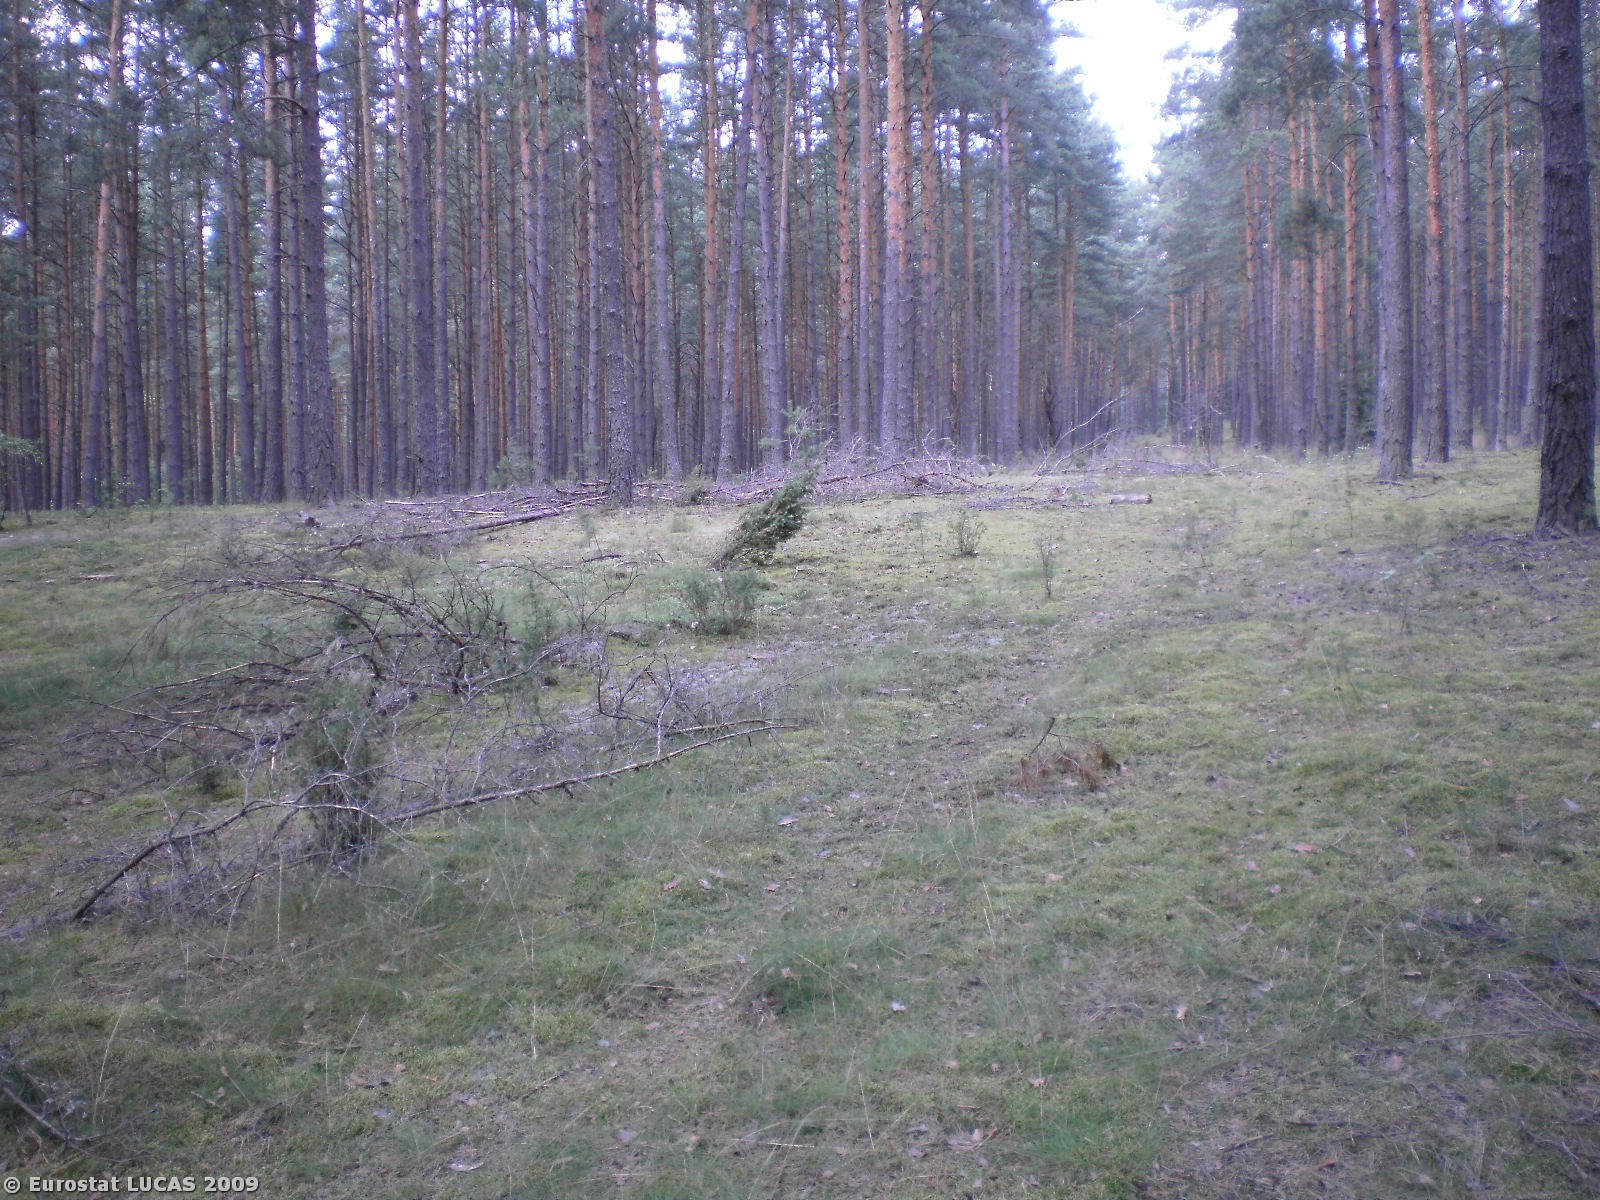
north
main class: Woodland
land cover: Coniferous woodland
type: hemiboreal forest and nemoral coniferous forest and mixed broadleaved-coniferous forest
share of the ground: 50 - 75 %
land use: Forestry
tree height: > 5 m
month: July
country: PL
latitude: 53.5483
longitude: 20.4352
